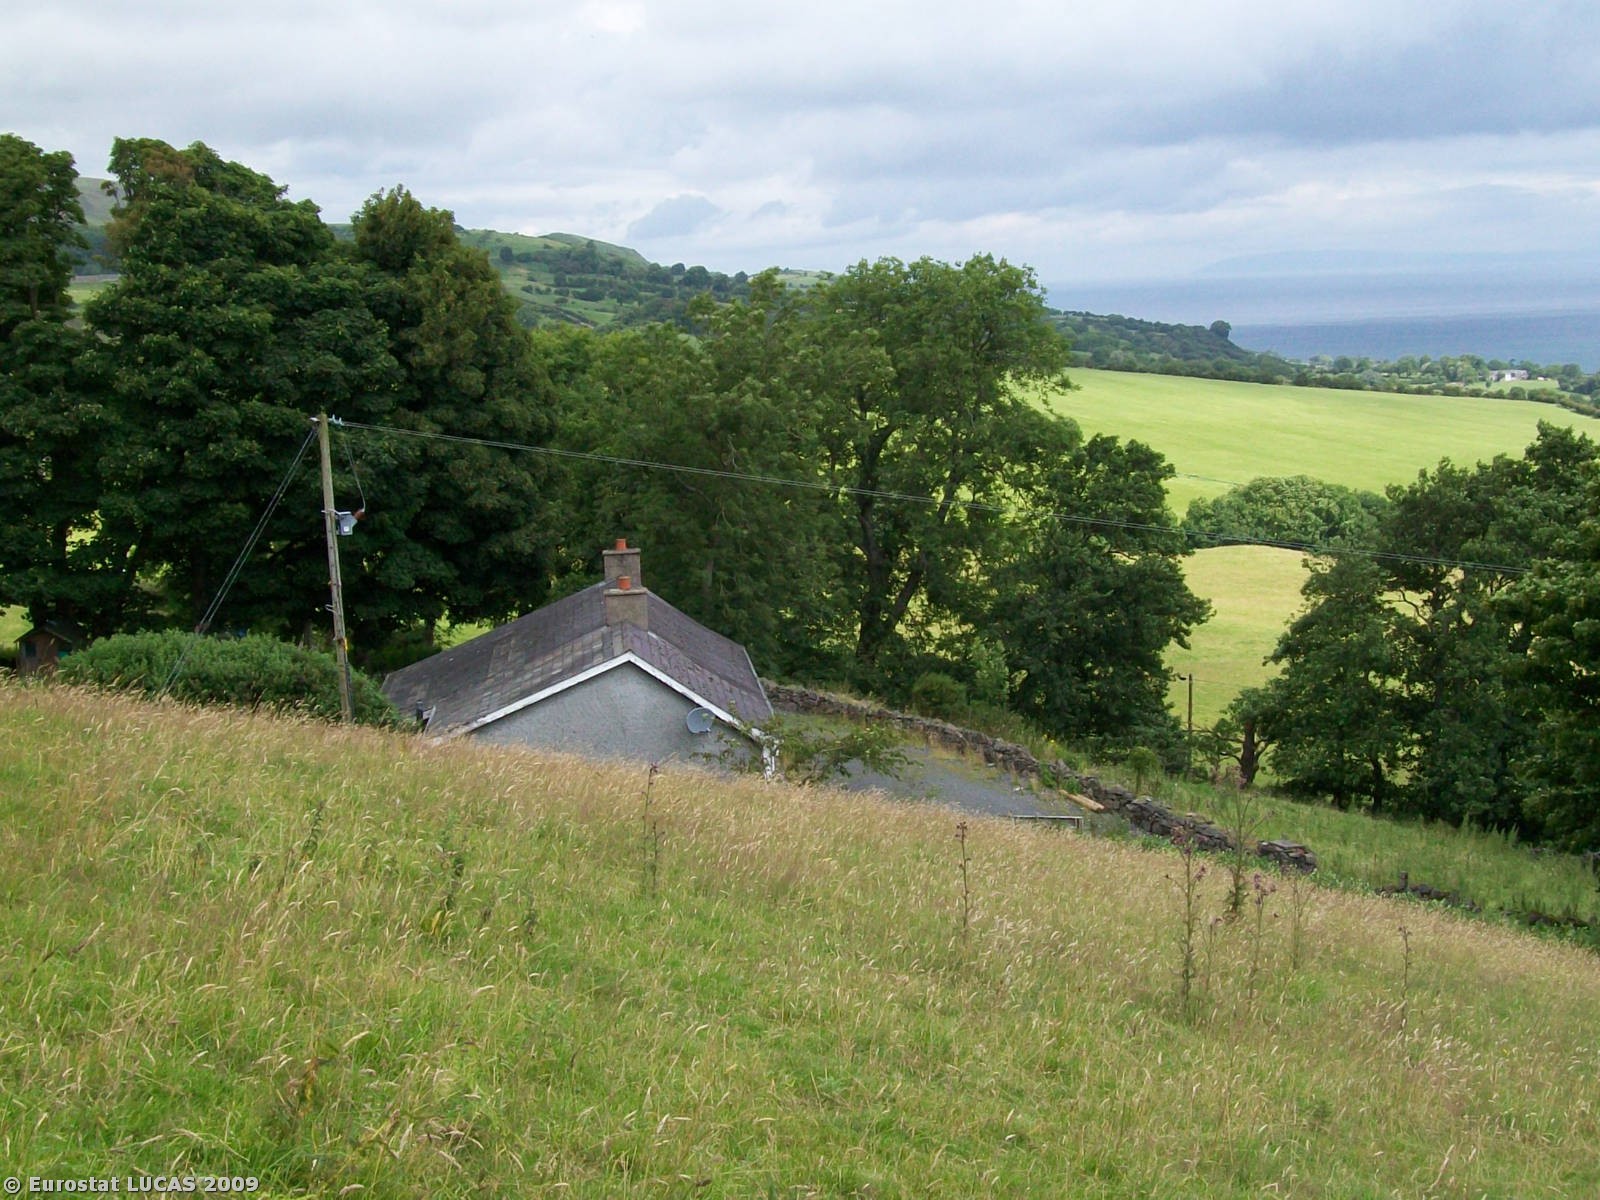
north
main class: Grassland
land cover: Grassland without tree/shrub cover
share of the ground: > 75 %
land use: Agriculture (excluding fallow land and kitchen gardens)
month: July
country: GB
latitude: 54.8929
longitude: -5.9000
